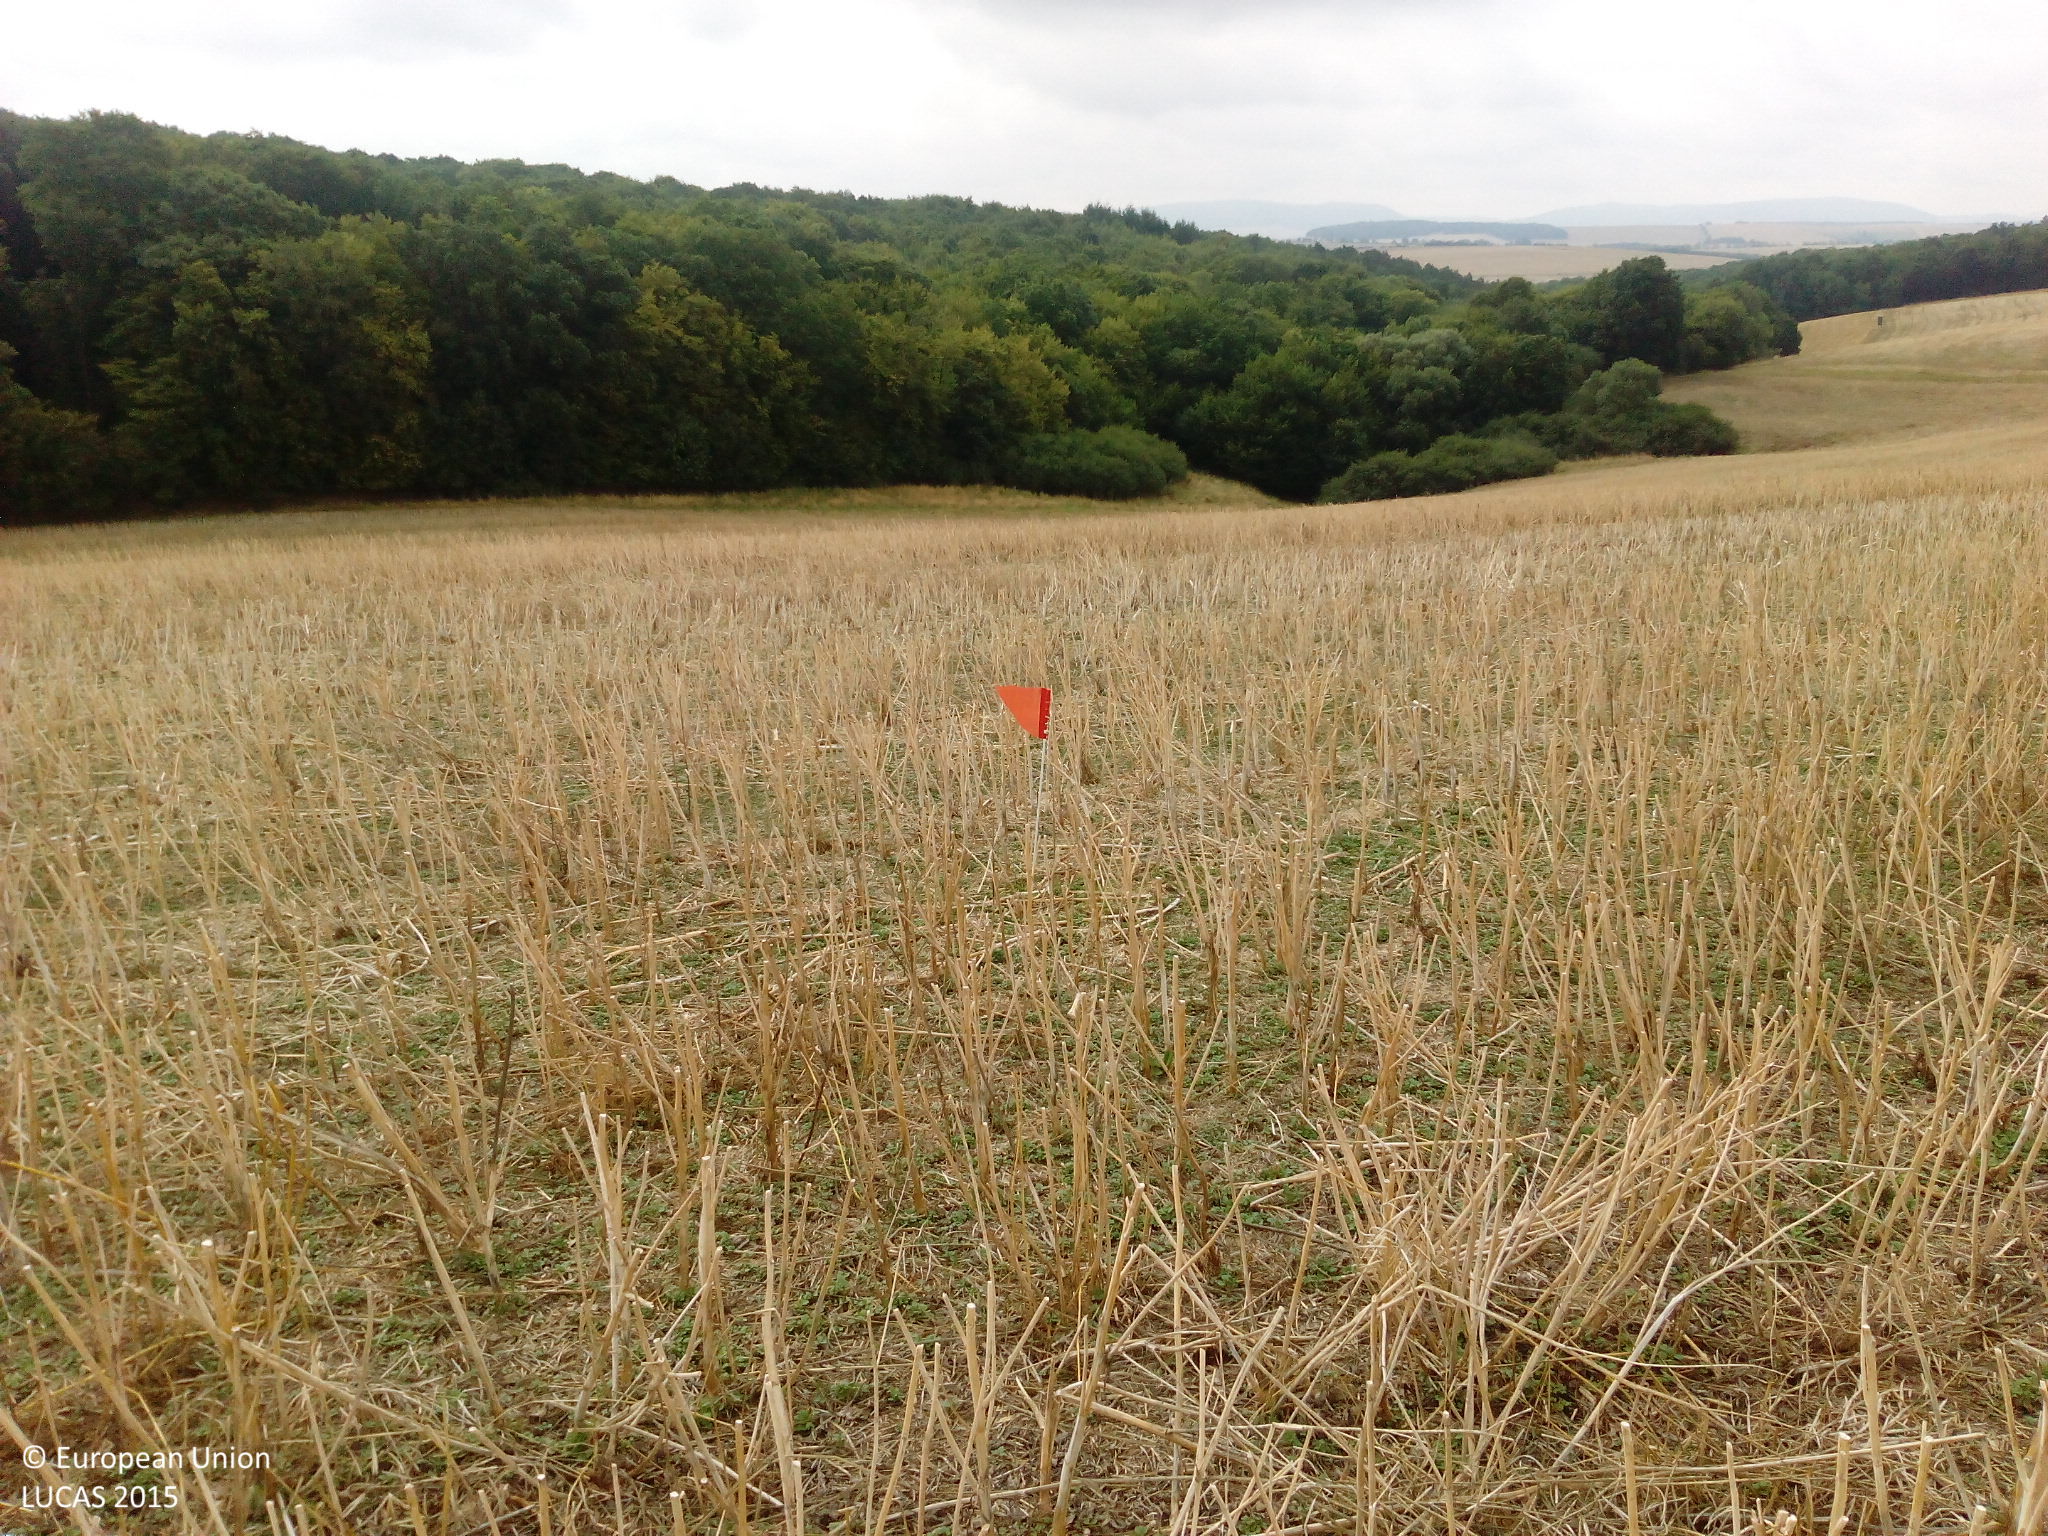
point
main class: Cropland
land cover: Rape and turnip rape
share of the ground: < 10 %
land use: Agriculture (excluding fallow land and kitchen gardens)
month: August
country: DE
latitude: 49.6901
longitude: 7.5468
